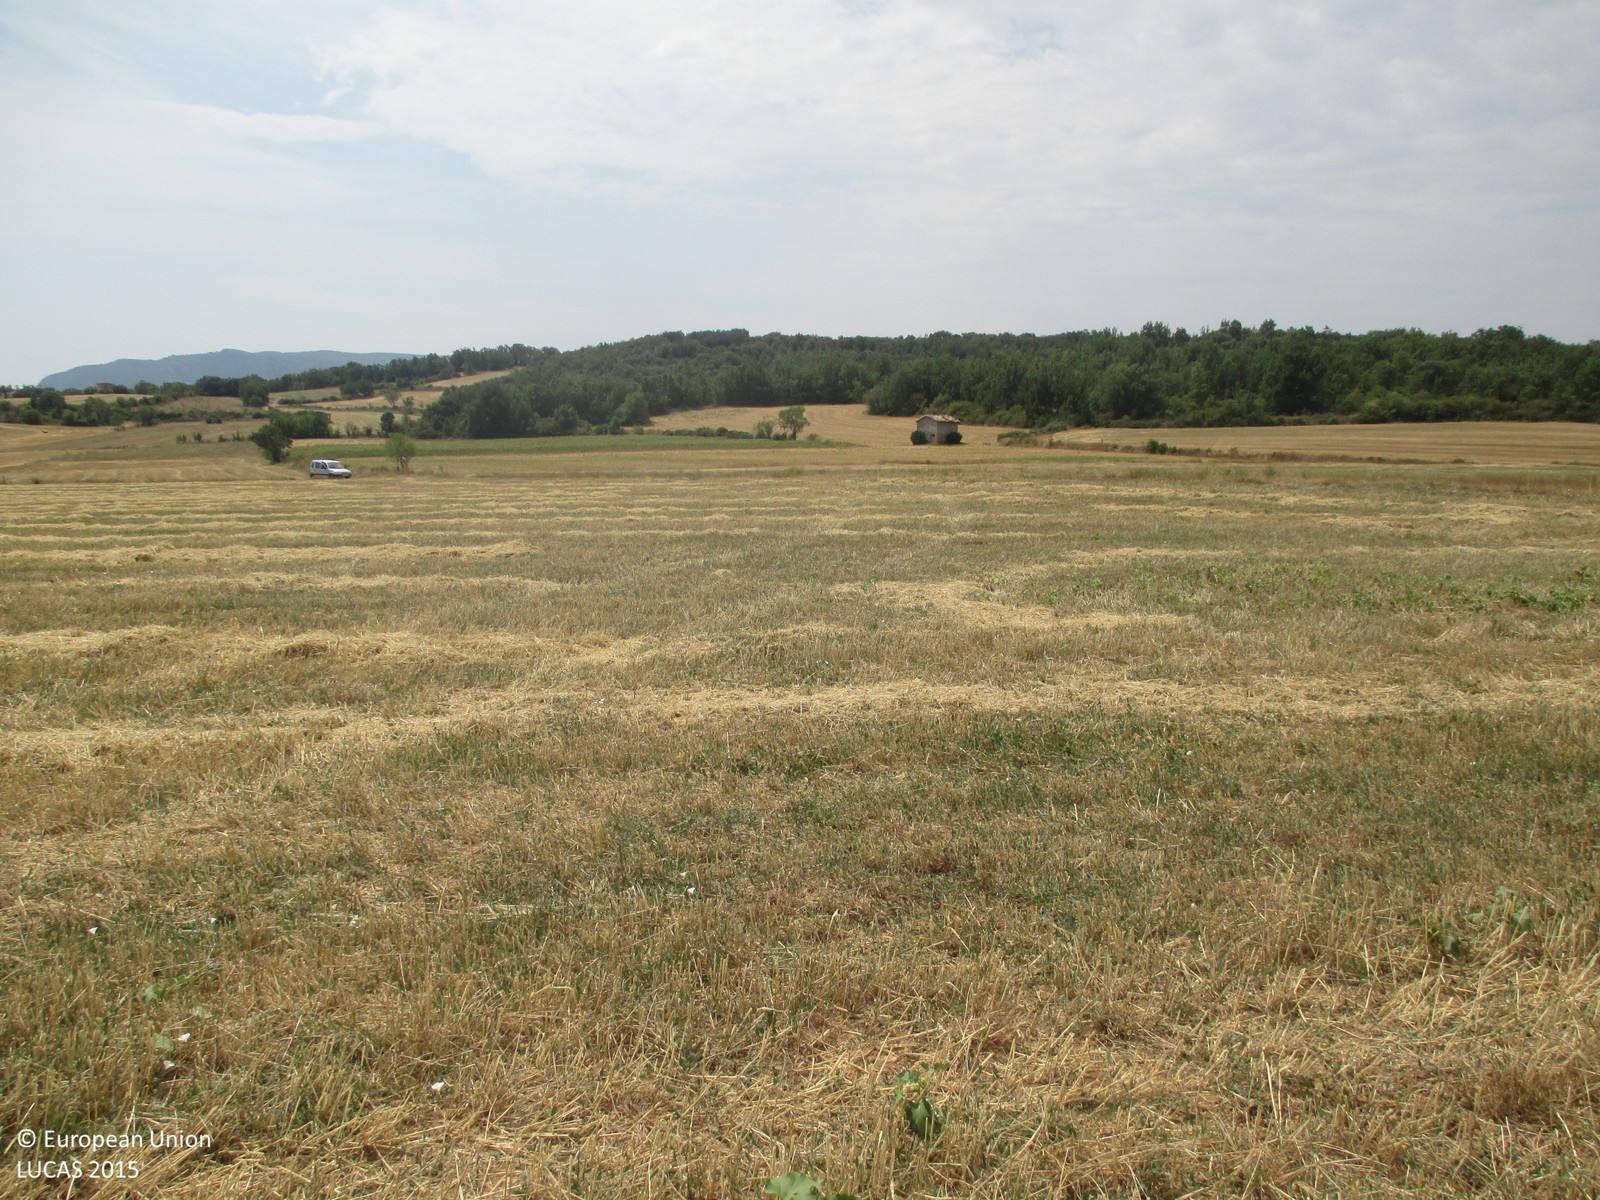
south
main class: Cropland
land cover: Barley
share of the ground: < 10 %
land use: Agriculture (excluding fallow land and kitchen gardens)
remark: Harvested field
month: July
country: ES
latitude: 42.1679
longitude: 0.2858
